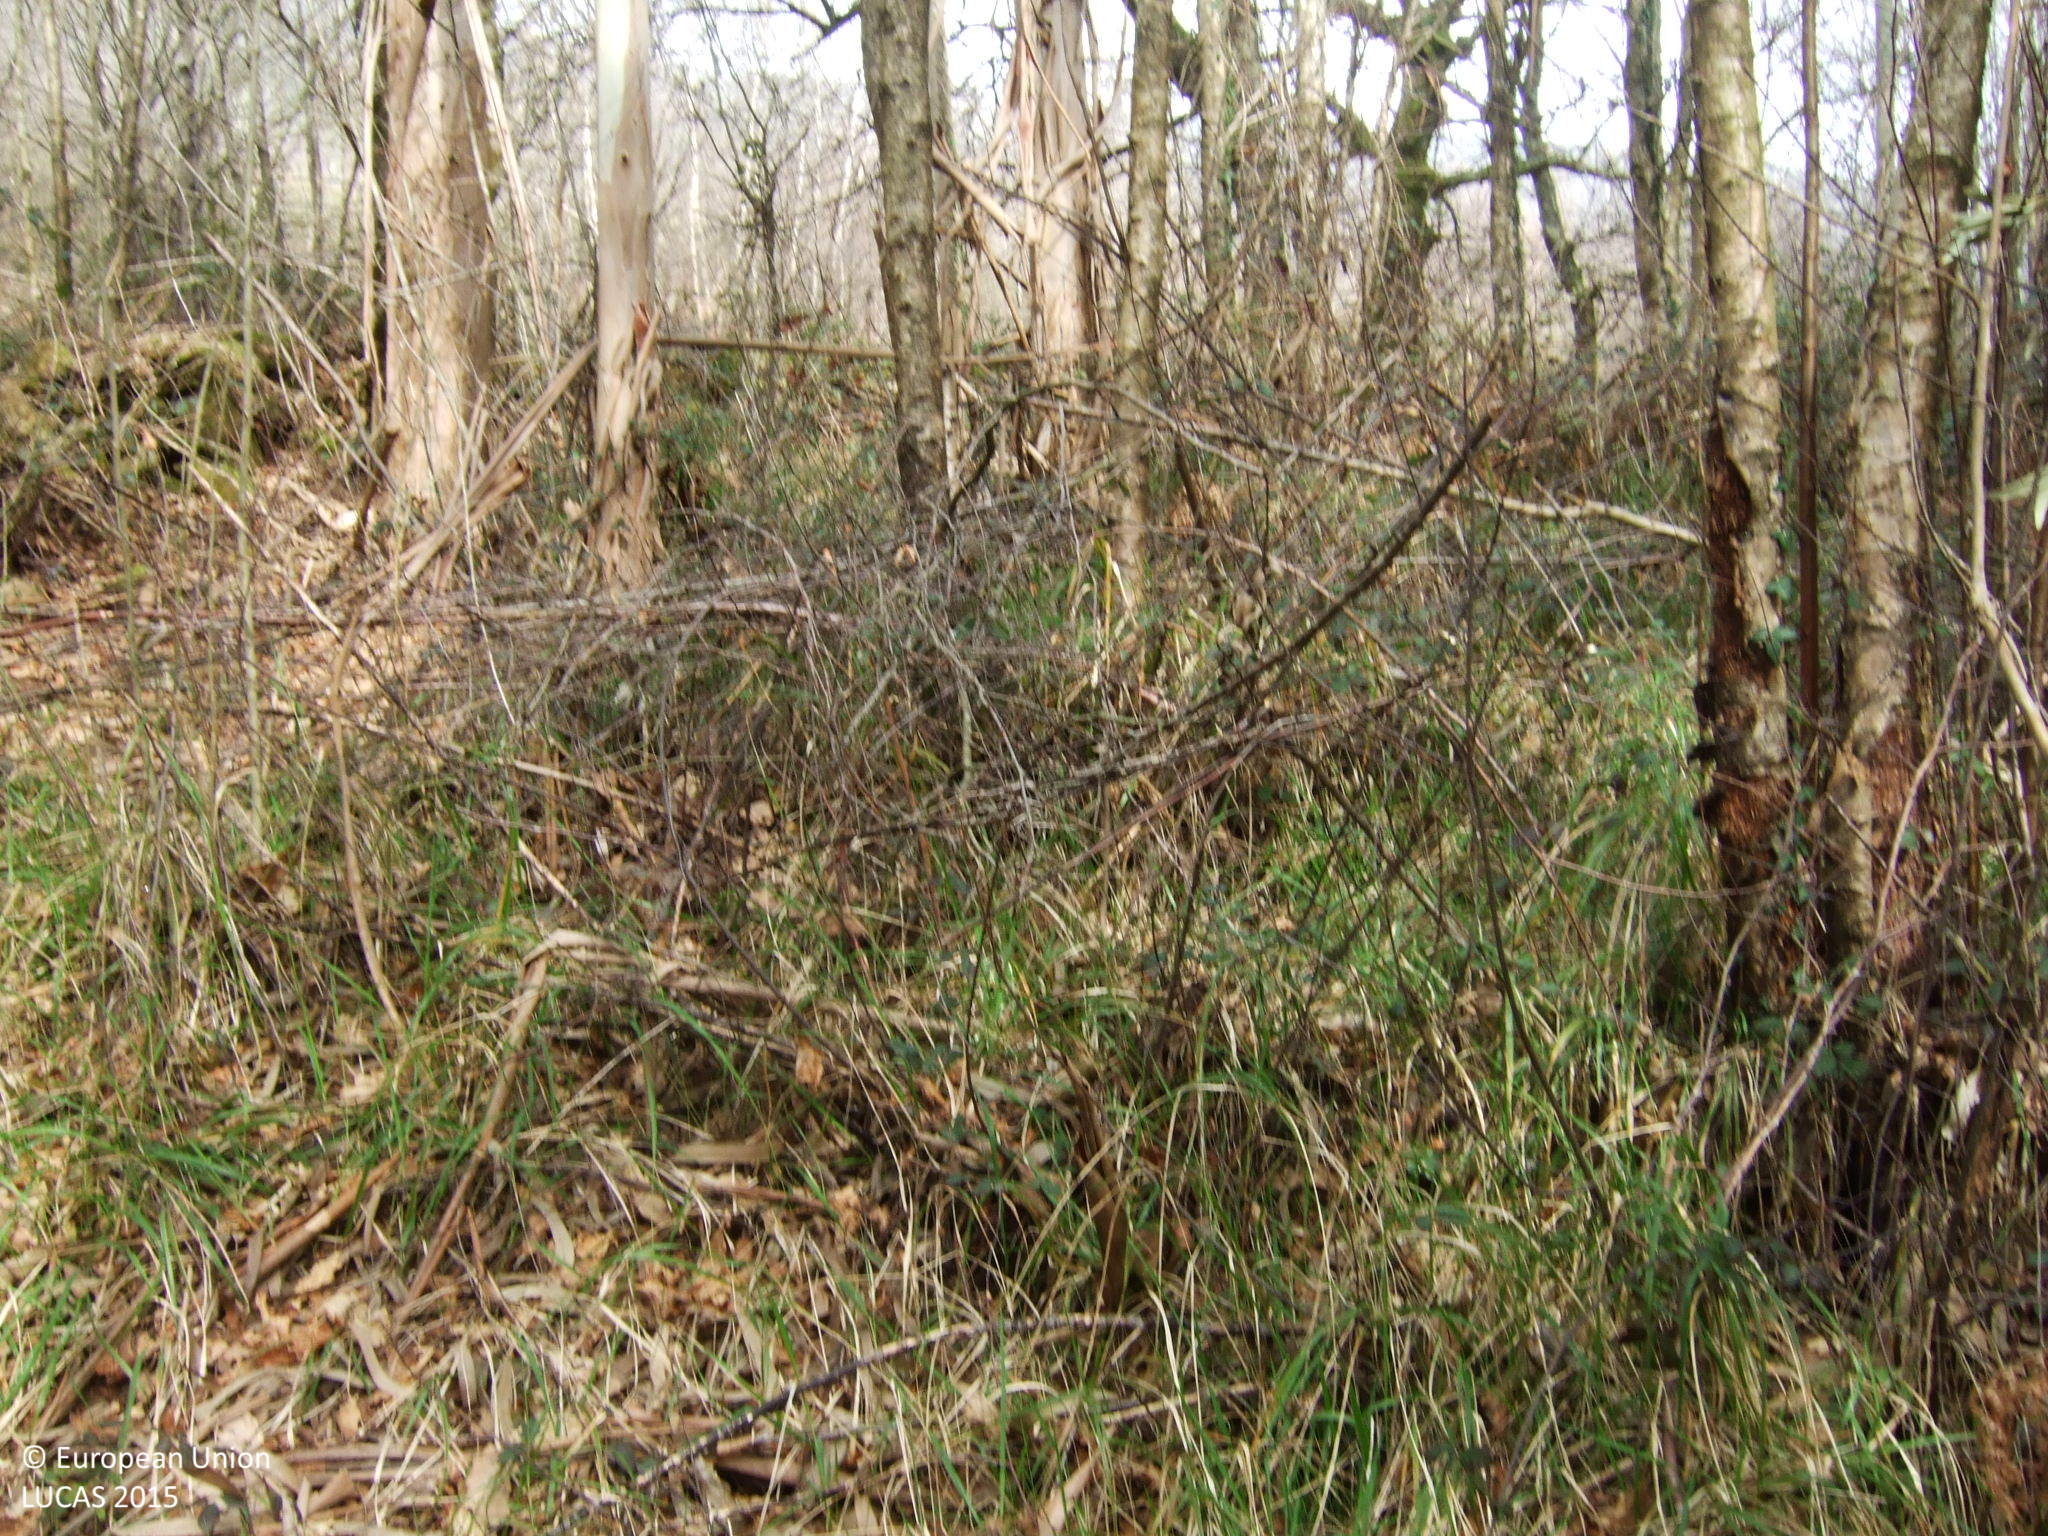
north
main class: Woodland
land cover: Broadleaved woodland
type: exotic forest
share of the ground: > 75 %
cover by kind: broadleaved forest trees 90 %, shrubs 10 %
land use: Forestry
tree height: > 5 m
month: March
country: ES
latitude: 42.9238
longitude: -7.9123
